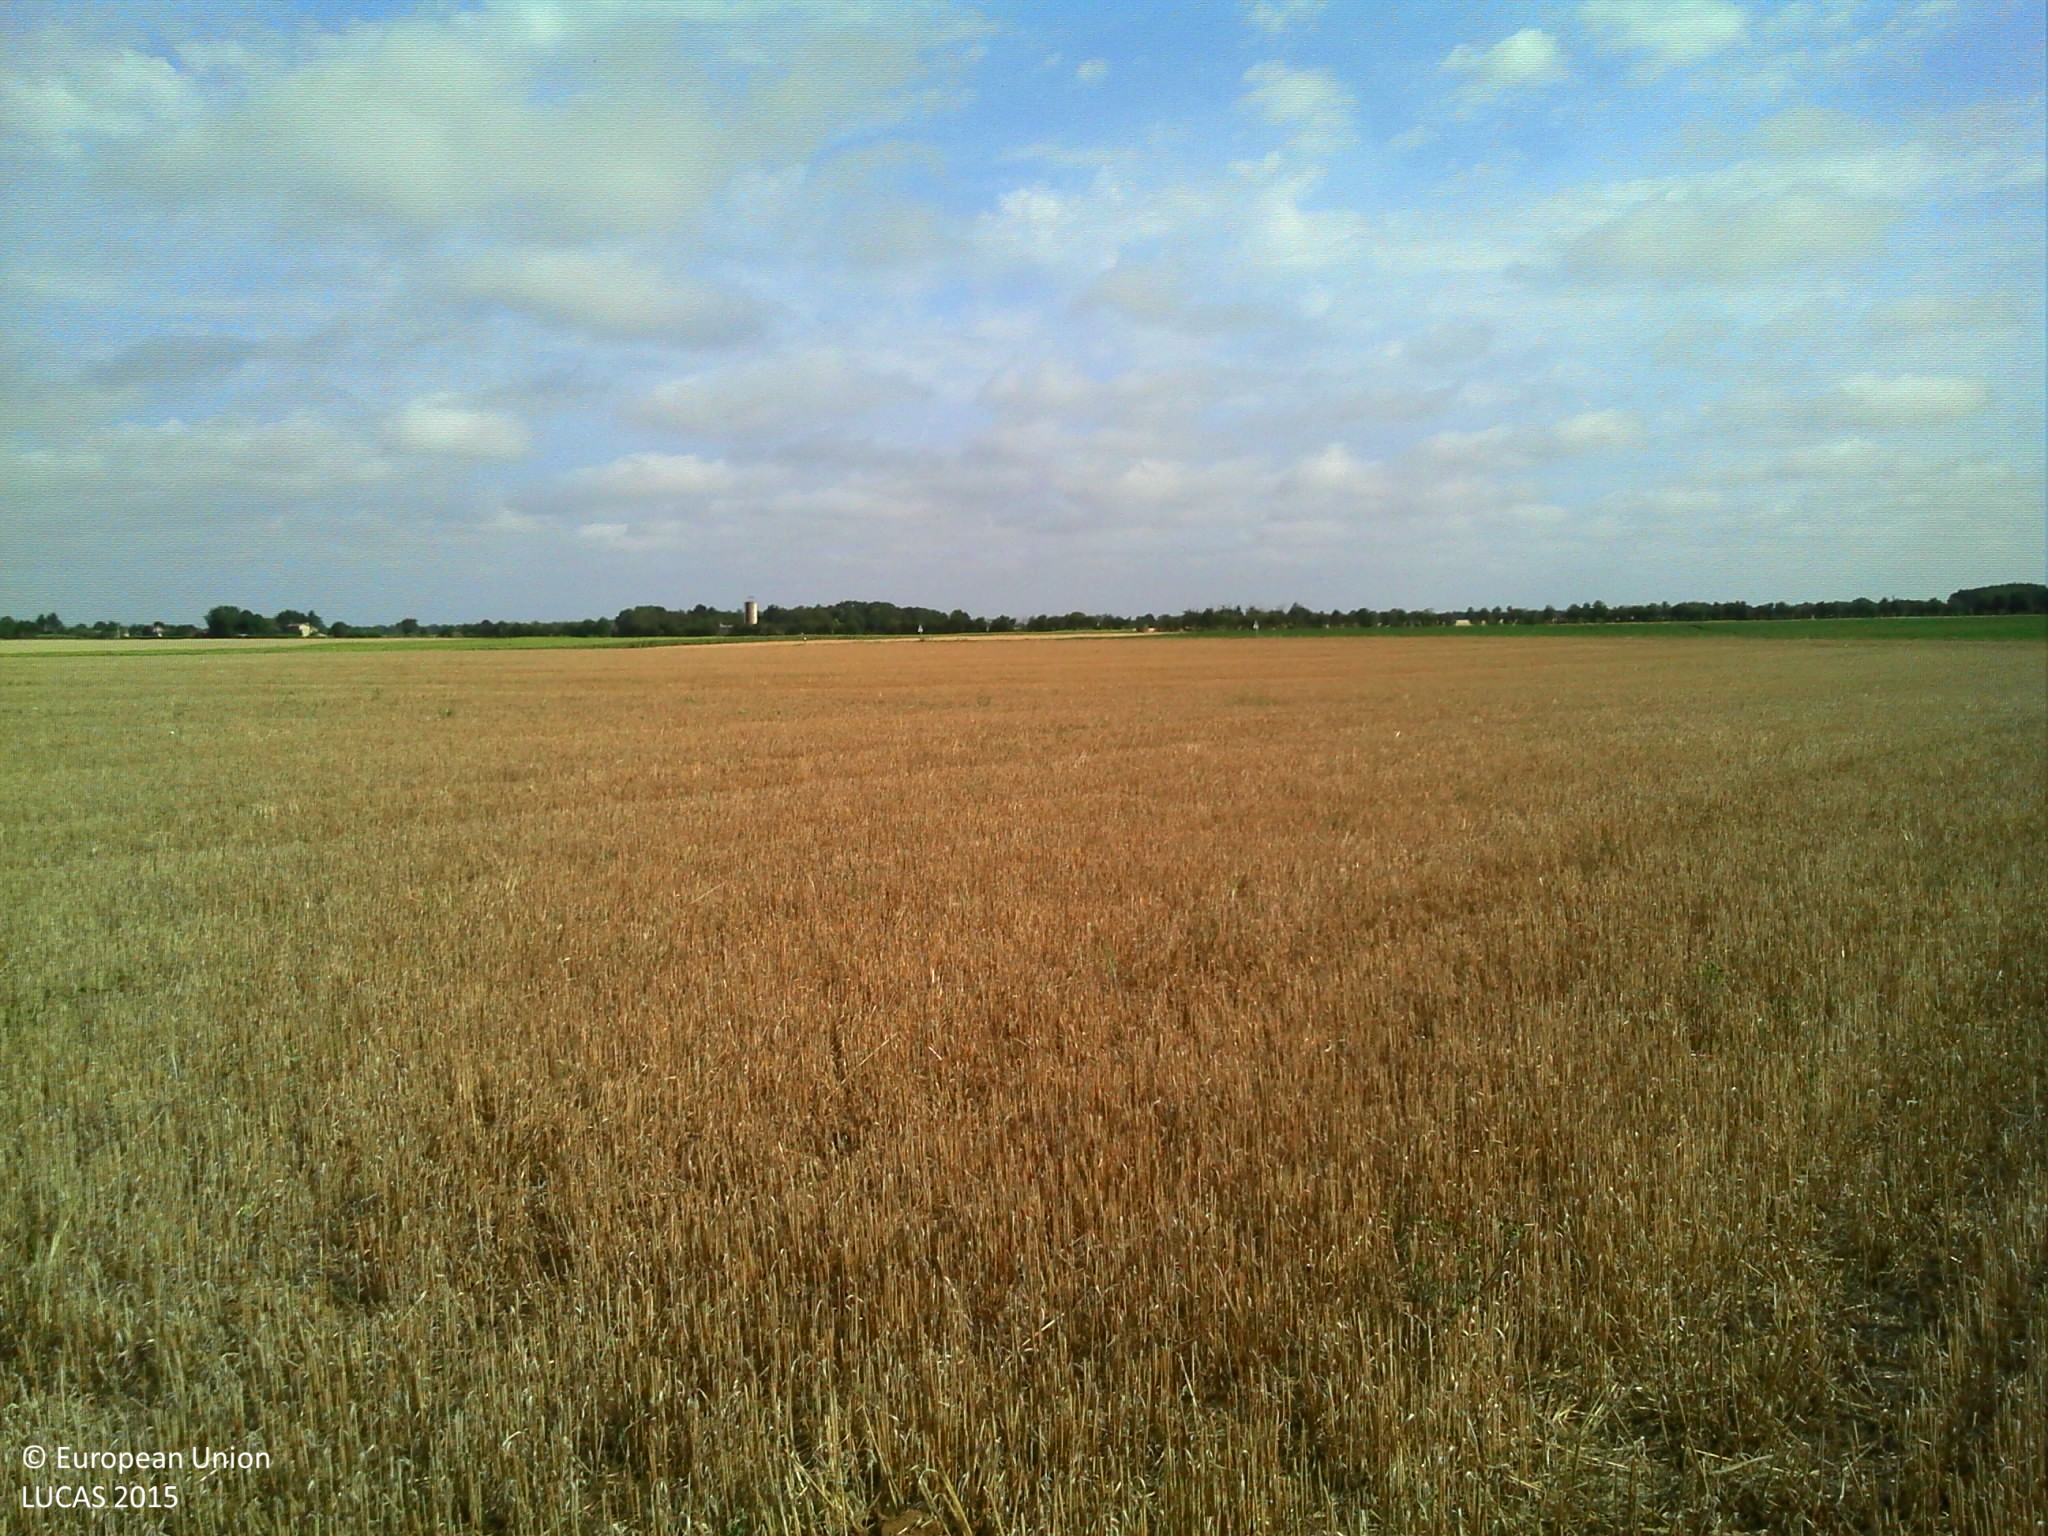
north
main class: Cropland
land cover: Common wheat
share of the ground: > 75 %
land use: Agriculture (excluding fallow land and kitchen gardens)
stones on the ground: 10 - 25 %
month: August
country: FR
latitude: 46.2664
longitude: 0.2373
